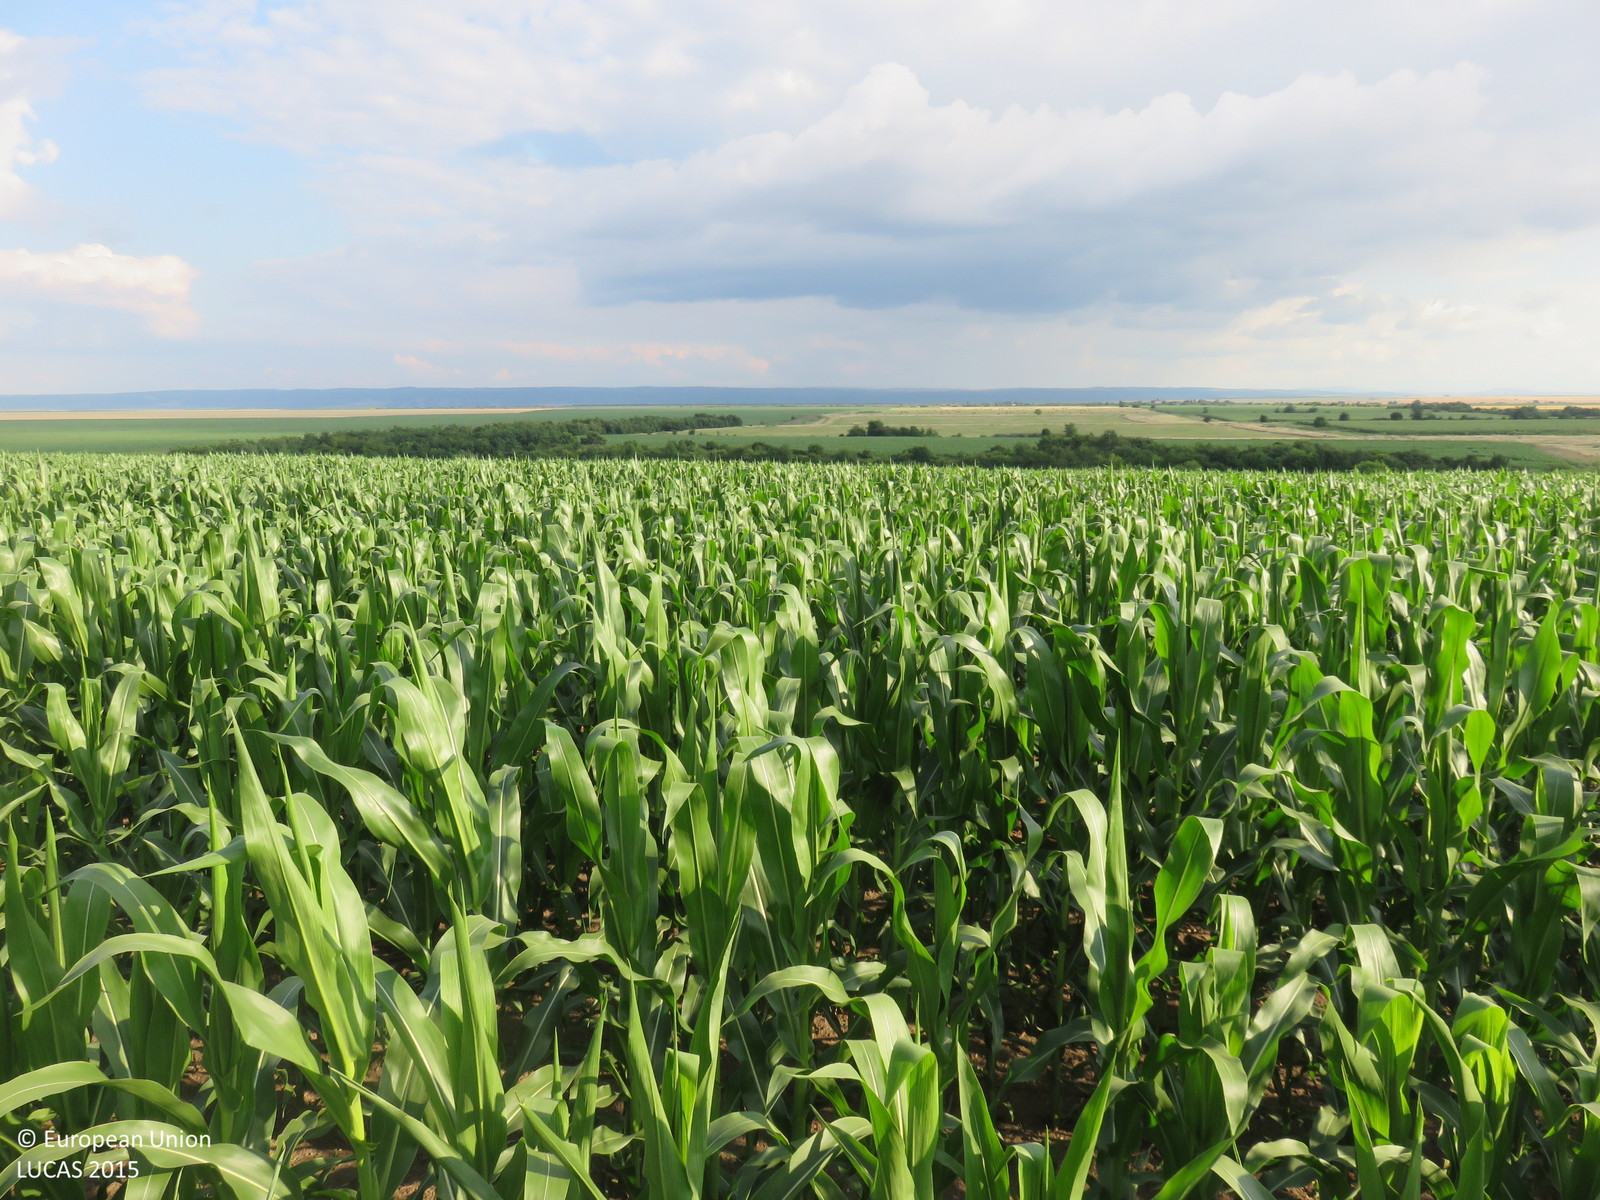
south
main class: Cropland
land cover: Maize
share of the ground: > 75 %
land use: Agriculture (excluding fallow land and kitchen gardens)
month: June
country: BG
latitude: 43.3717
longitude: 24.9400
